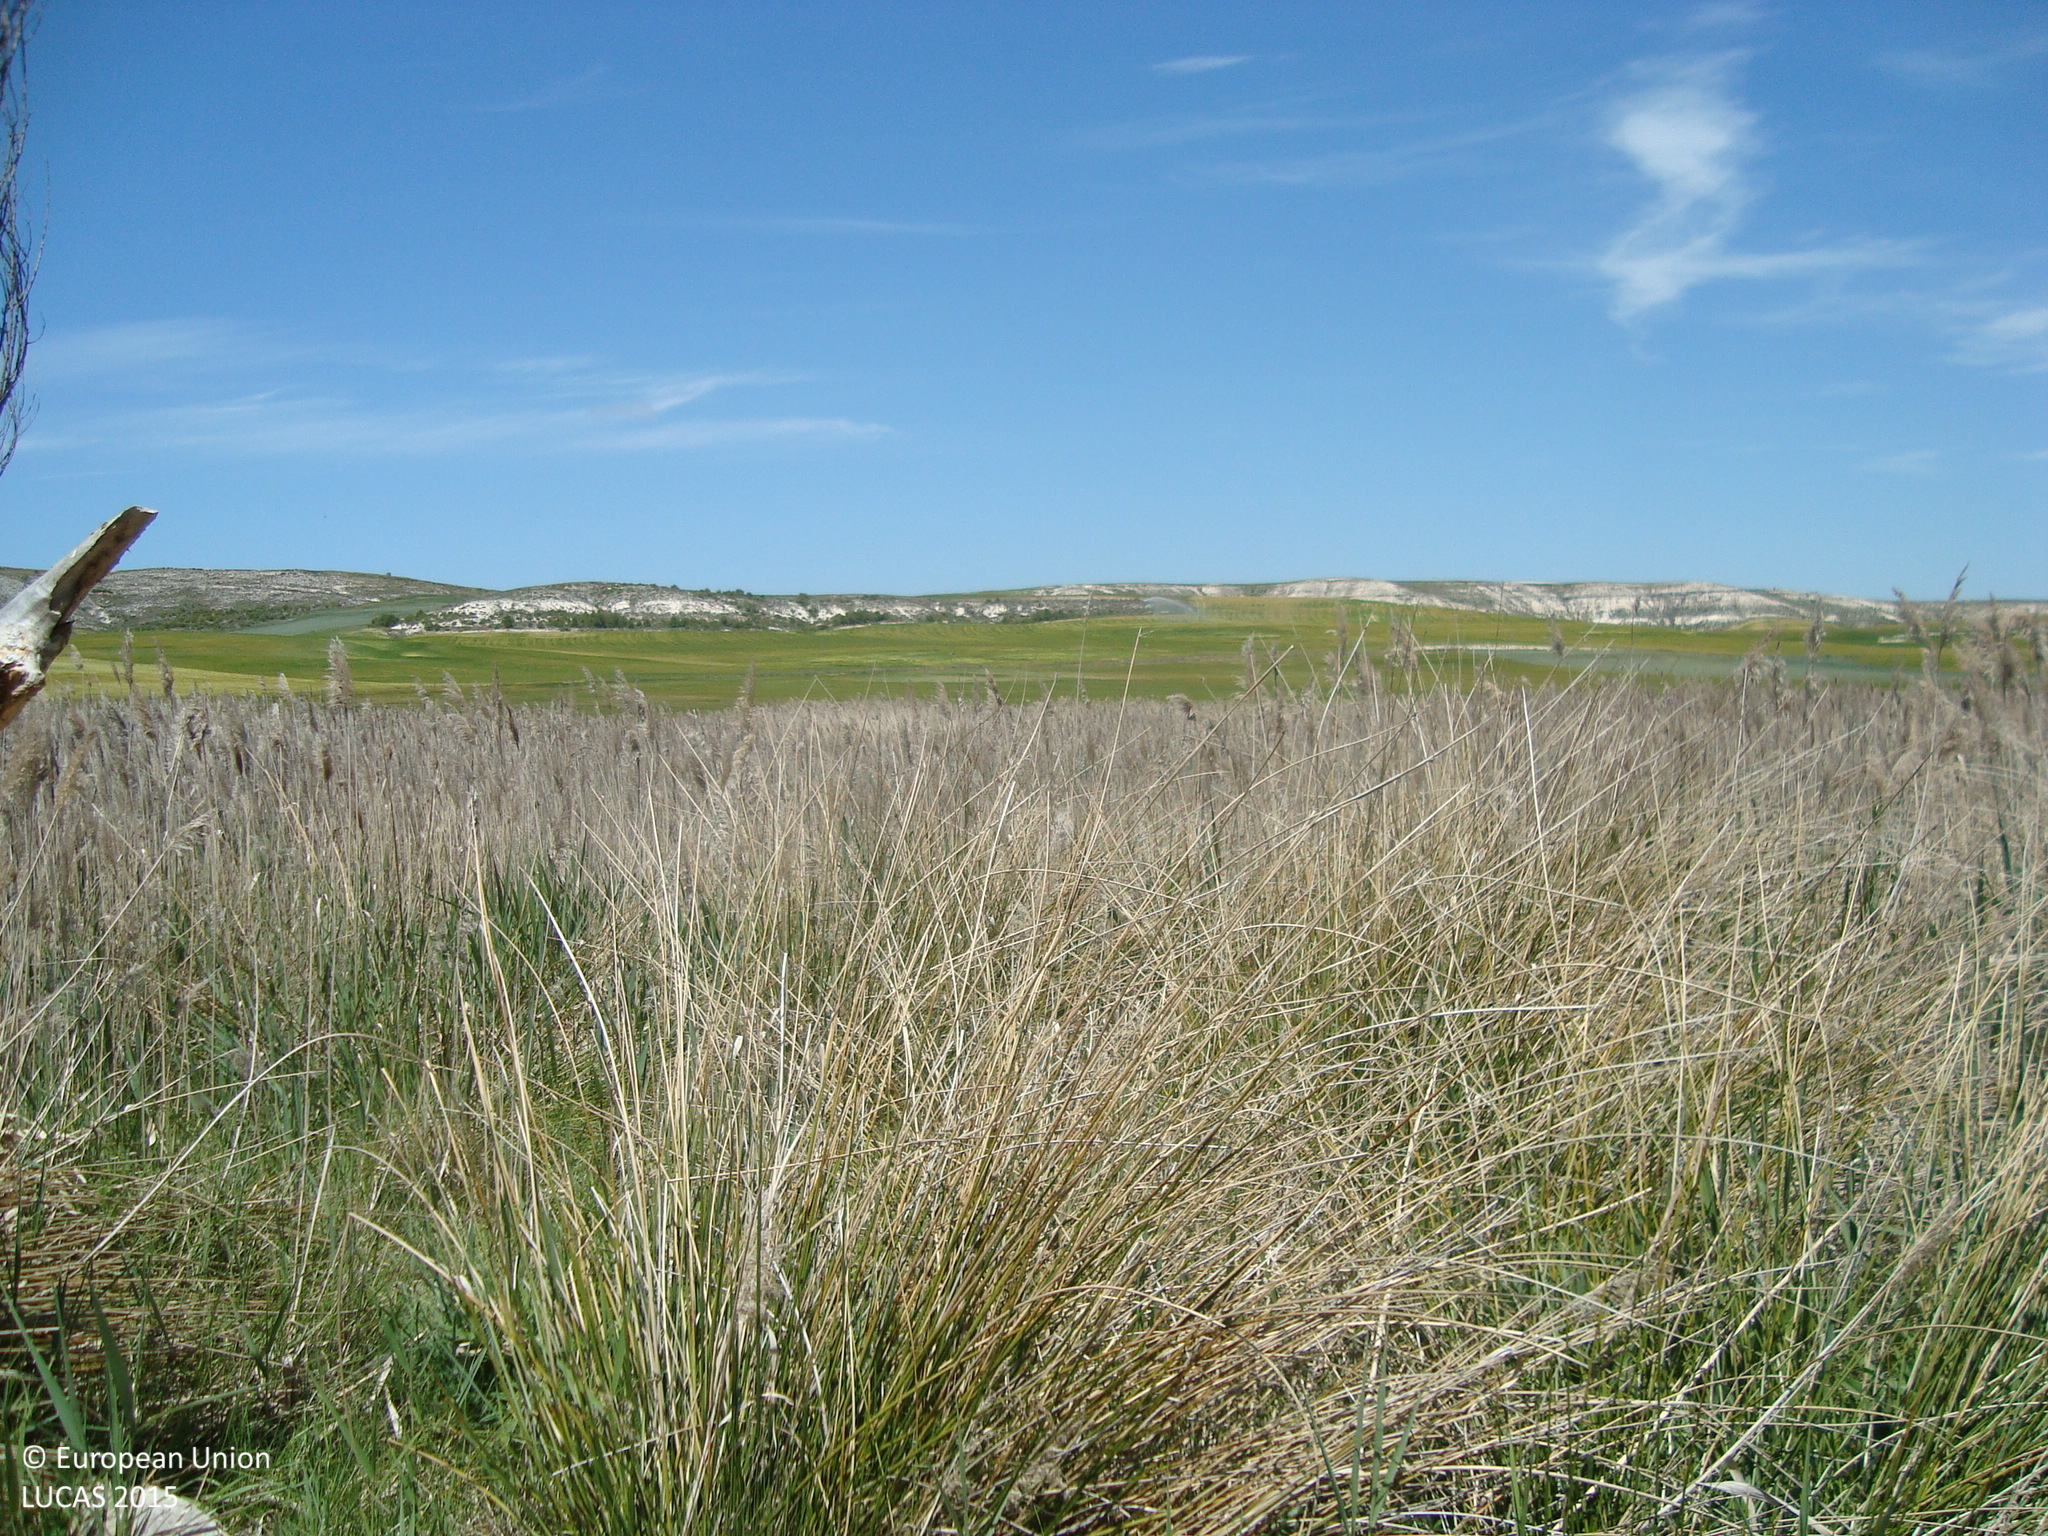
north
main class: Grassland
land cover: Grassland without tree/shrub cover
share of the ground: > 75 %
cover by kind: herbaceous plants 100 %
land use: Semi-natural and natural areas not in use
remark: Temporary flooded
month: May
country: ES
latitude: 41.5746
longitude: -4.1994
